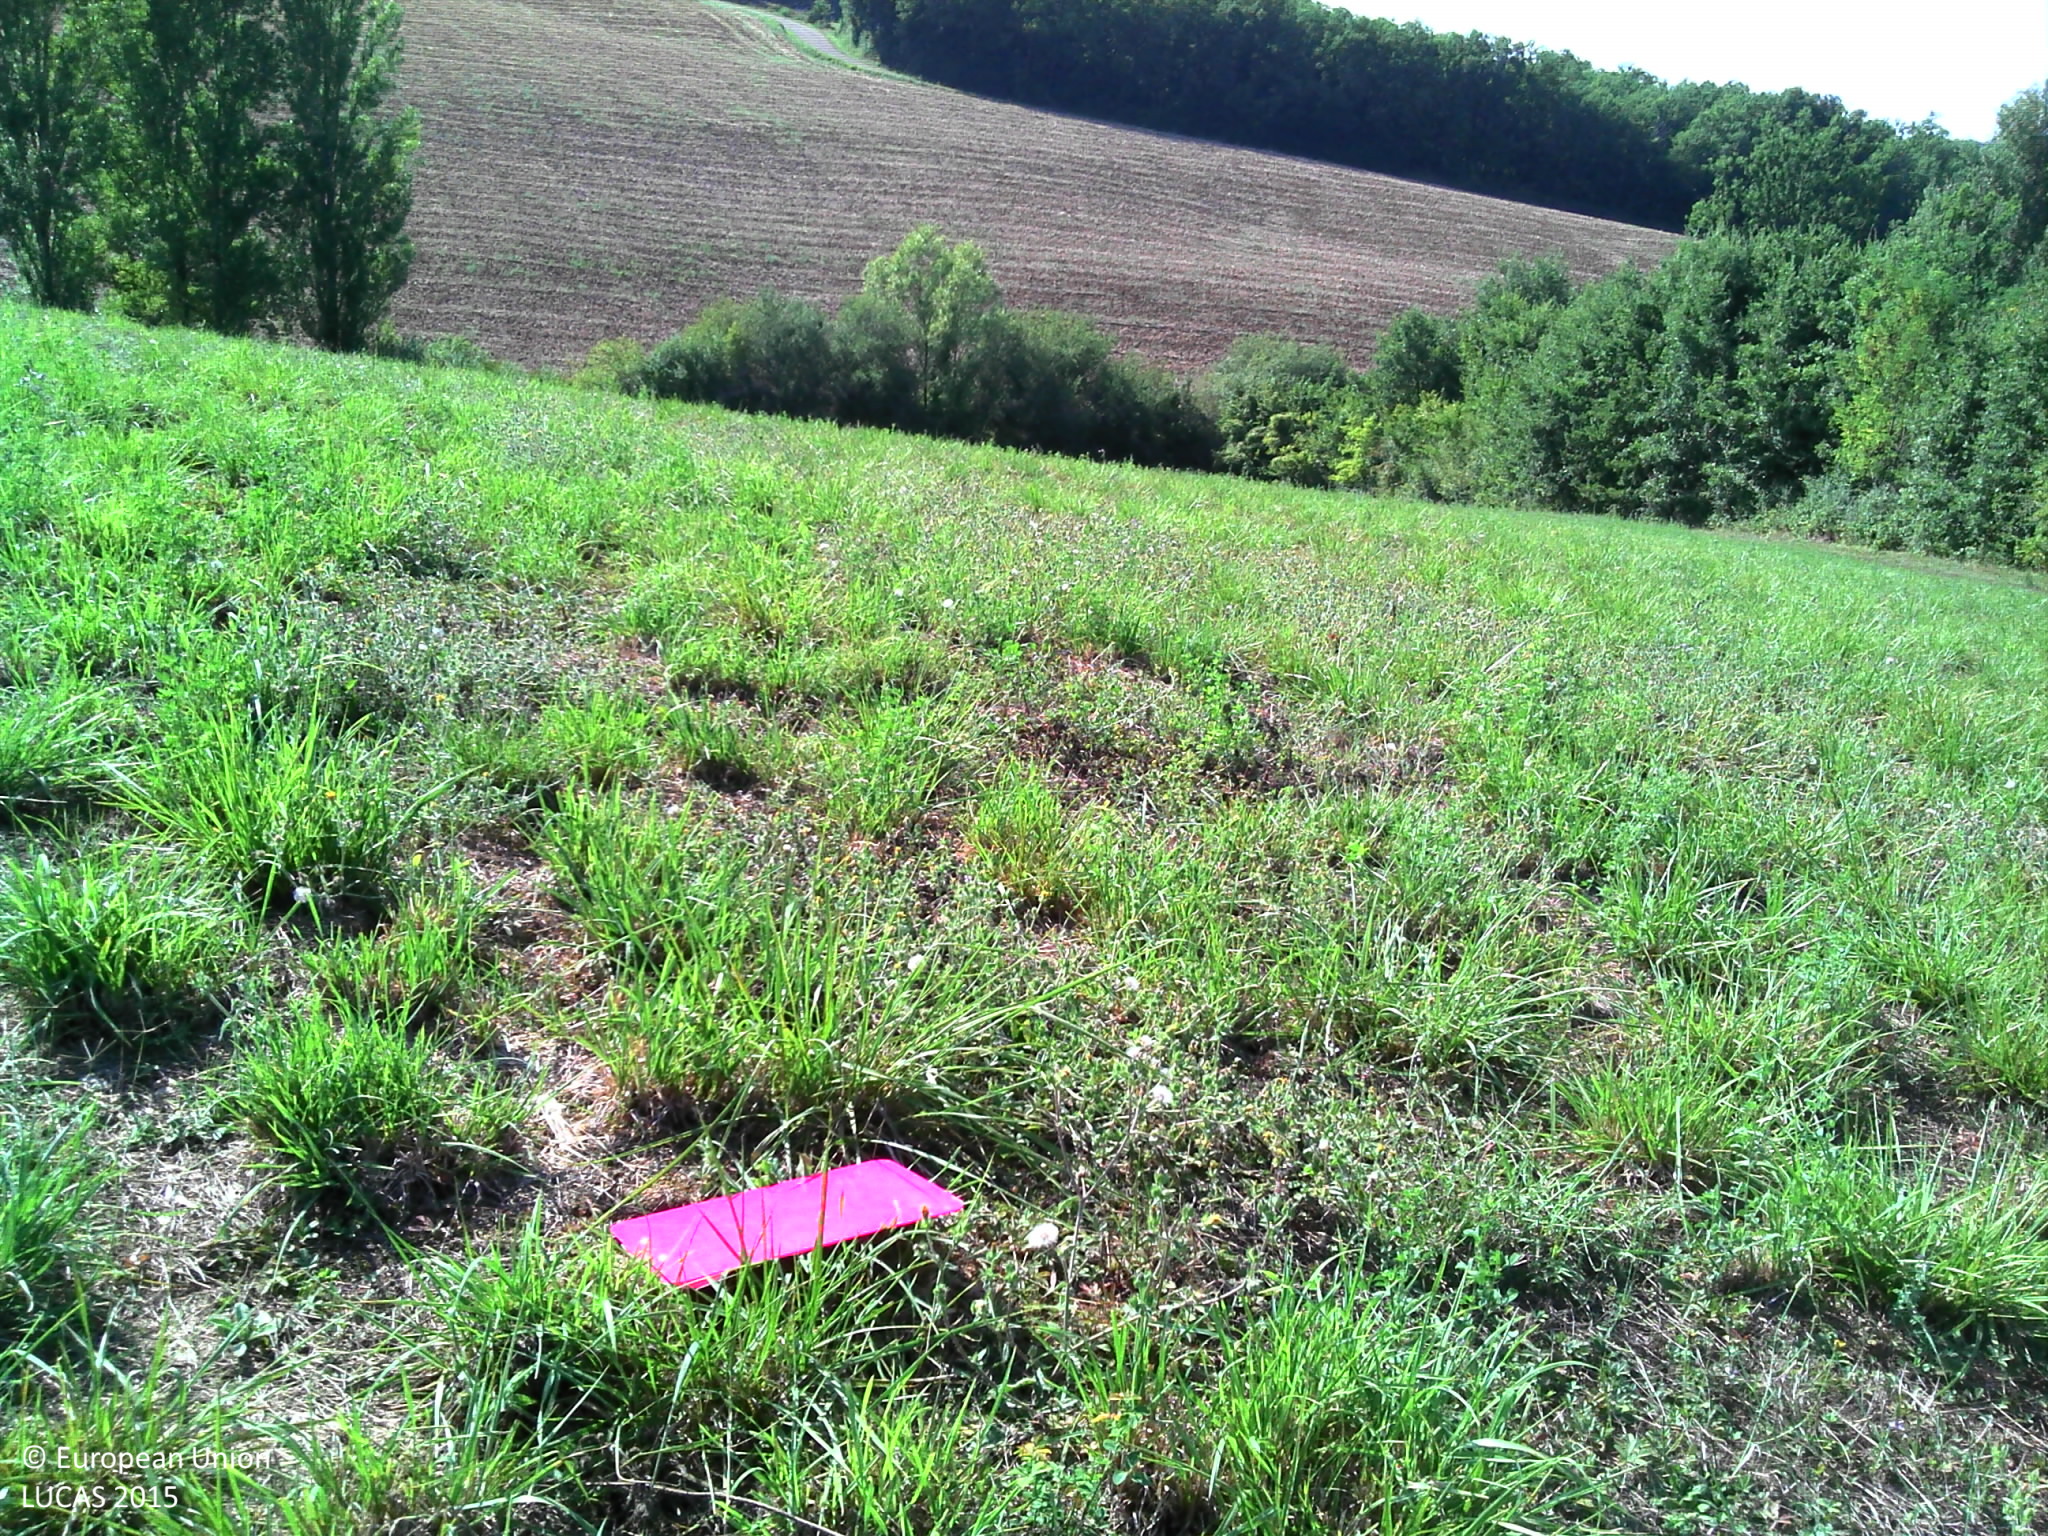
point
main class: Cropland
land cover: Temporary grasslands
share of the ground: > 75 %
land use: Agriculture (excluding fallow land and kitchen gardens)
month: August
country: FR
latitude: 43.9324
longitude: 1.5432
